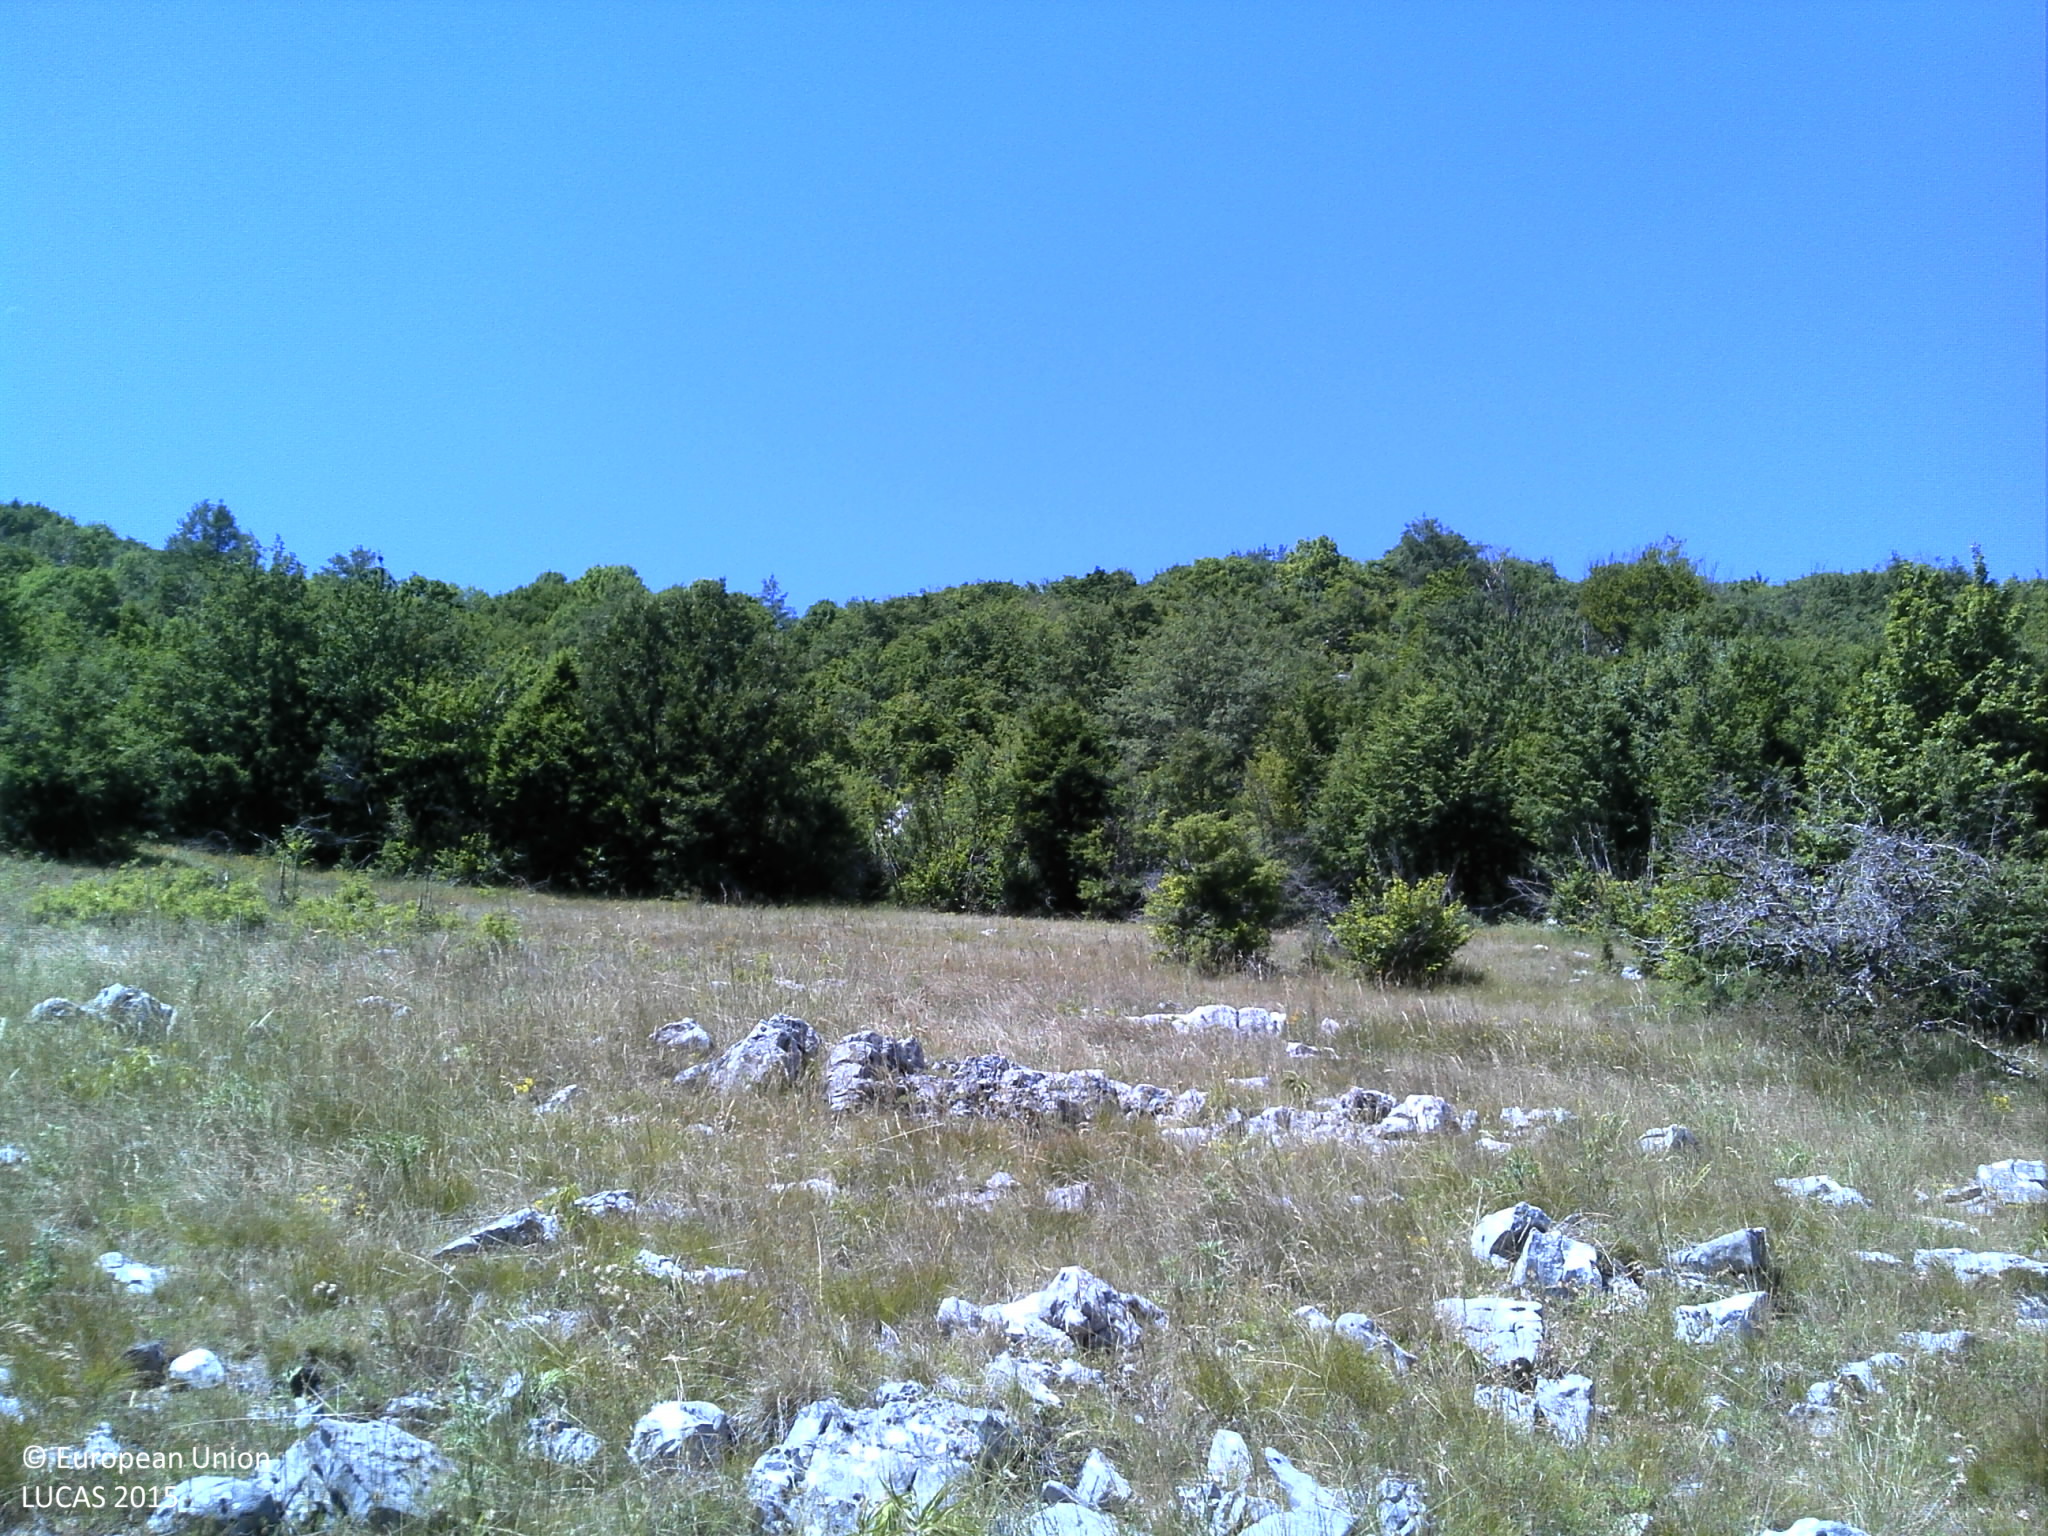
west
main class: Grassland
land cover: Grassland without tree/shrub cover
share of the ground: > 75 %
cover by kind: herbaceous plants 75 %, unconsolidated bare surface 15 %, shrubs 5 %, consolidated bare surface 5 %
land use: Semi-natural and natural areas not in use
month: July
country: HR
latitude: 44.4531
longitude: 15.9126
